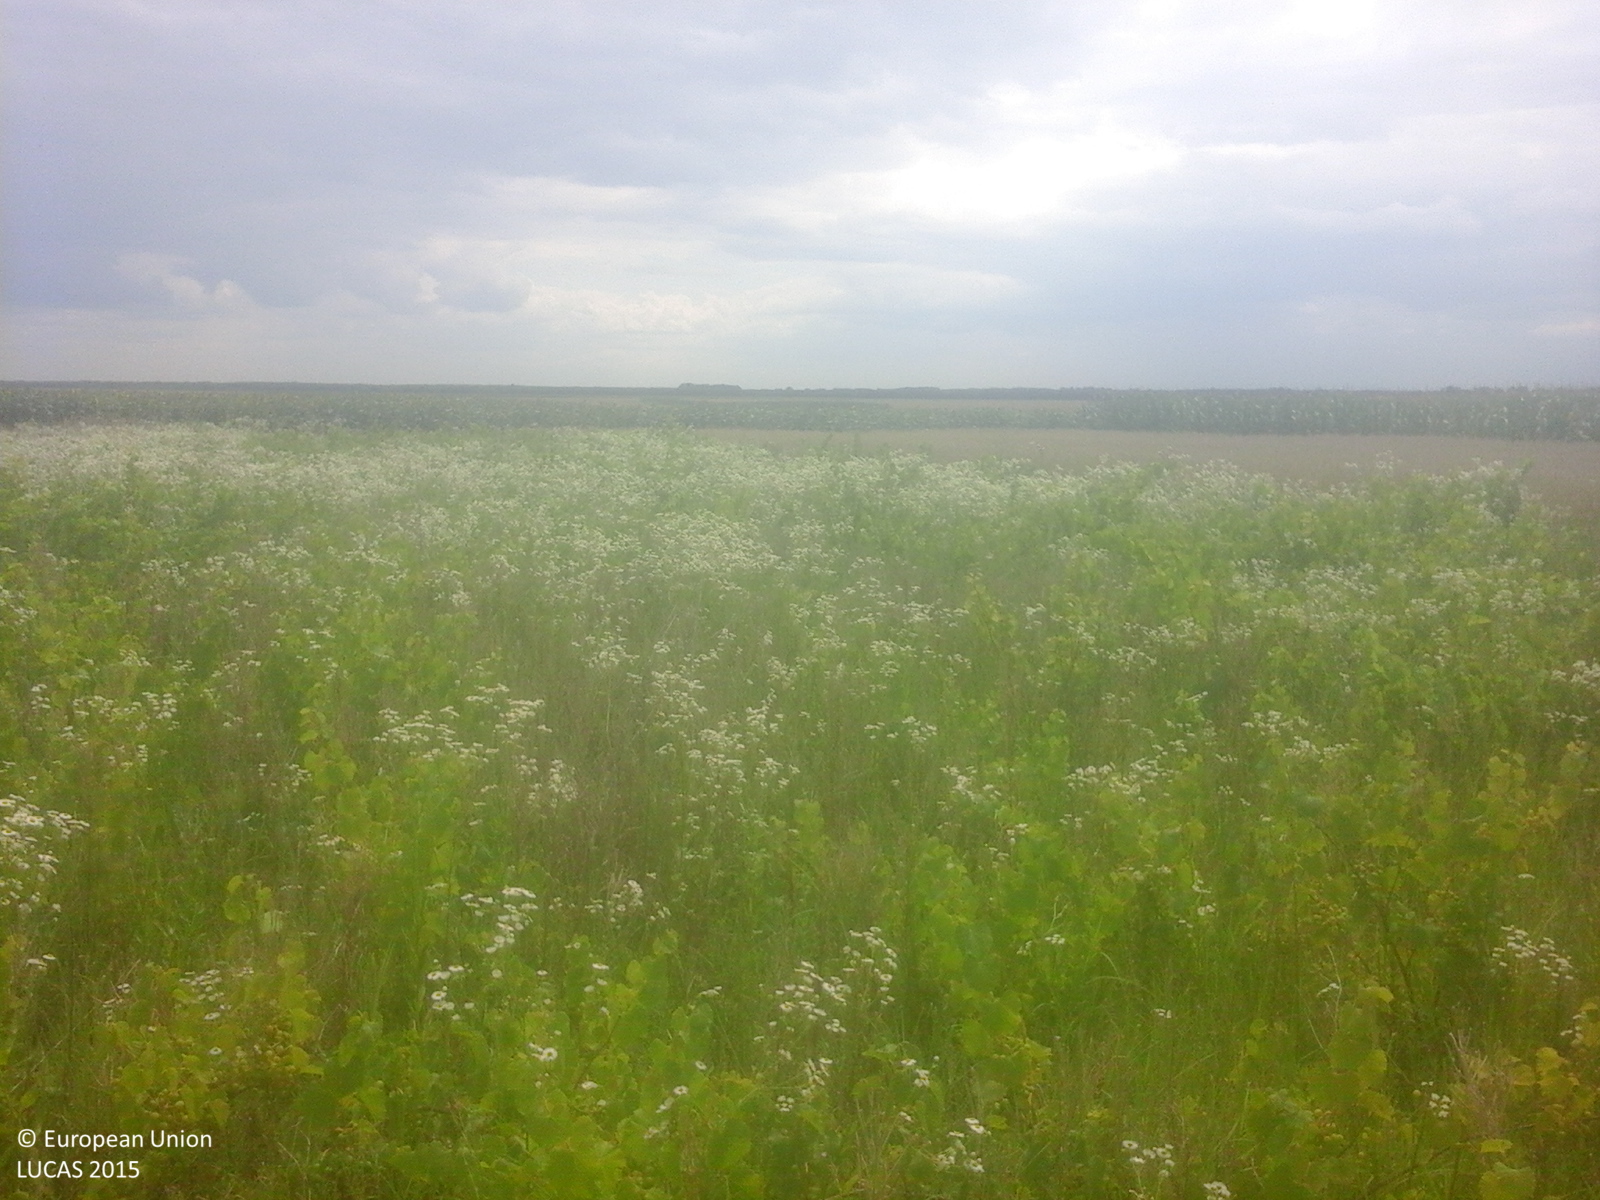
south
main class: Cropland
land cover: Vineyards
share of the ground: 50 - 75 %
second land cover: Spontaneously vegetated surfaces
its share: 50 - 75 %
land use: Abandoned areas
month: July
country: RO
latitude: 44.1451
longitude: 25.5281
